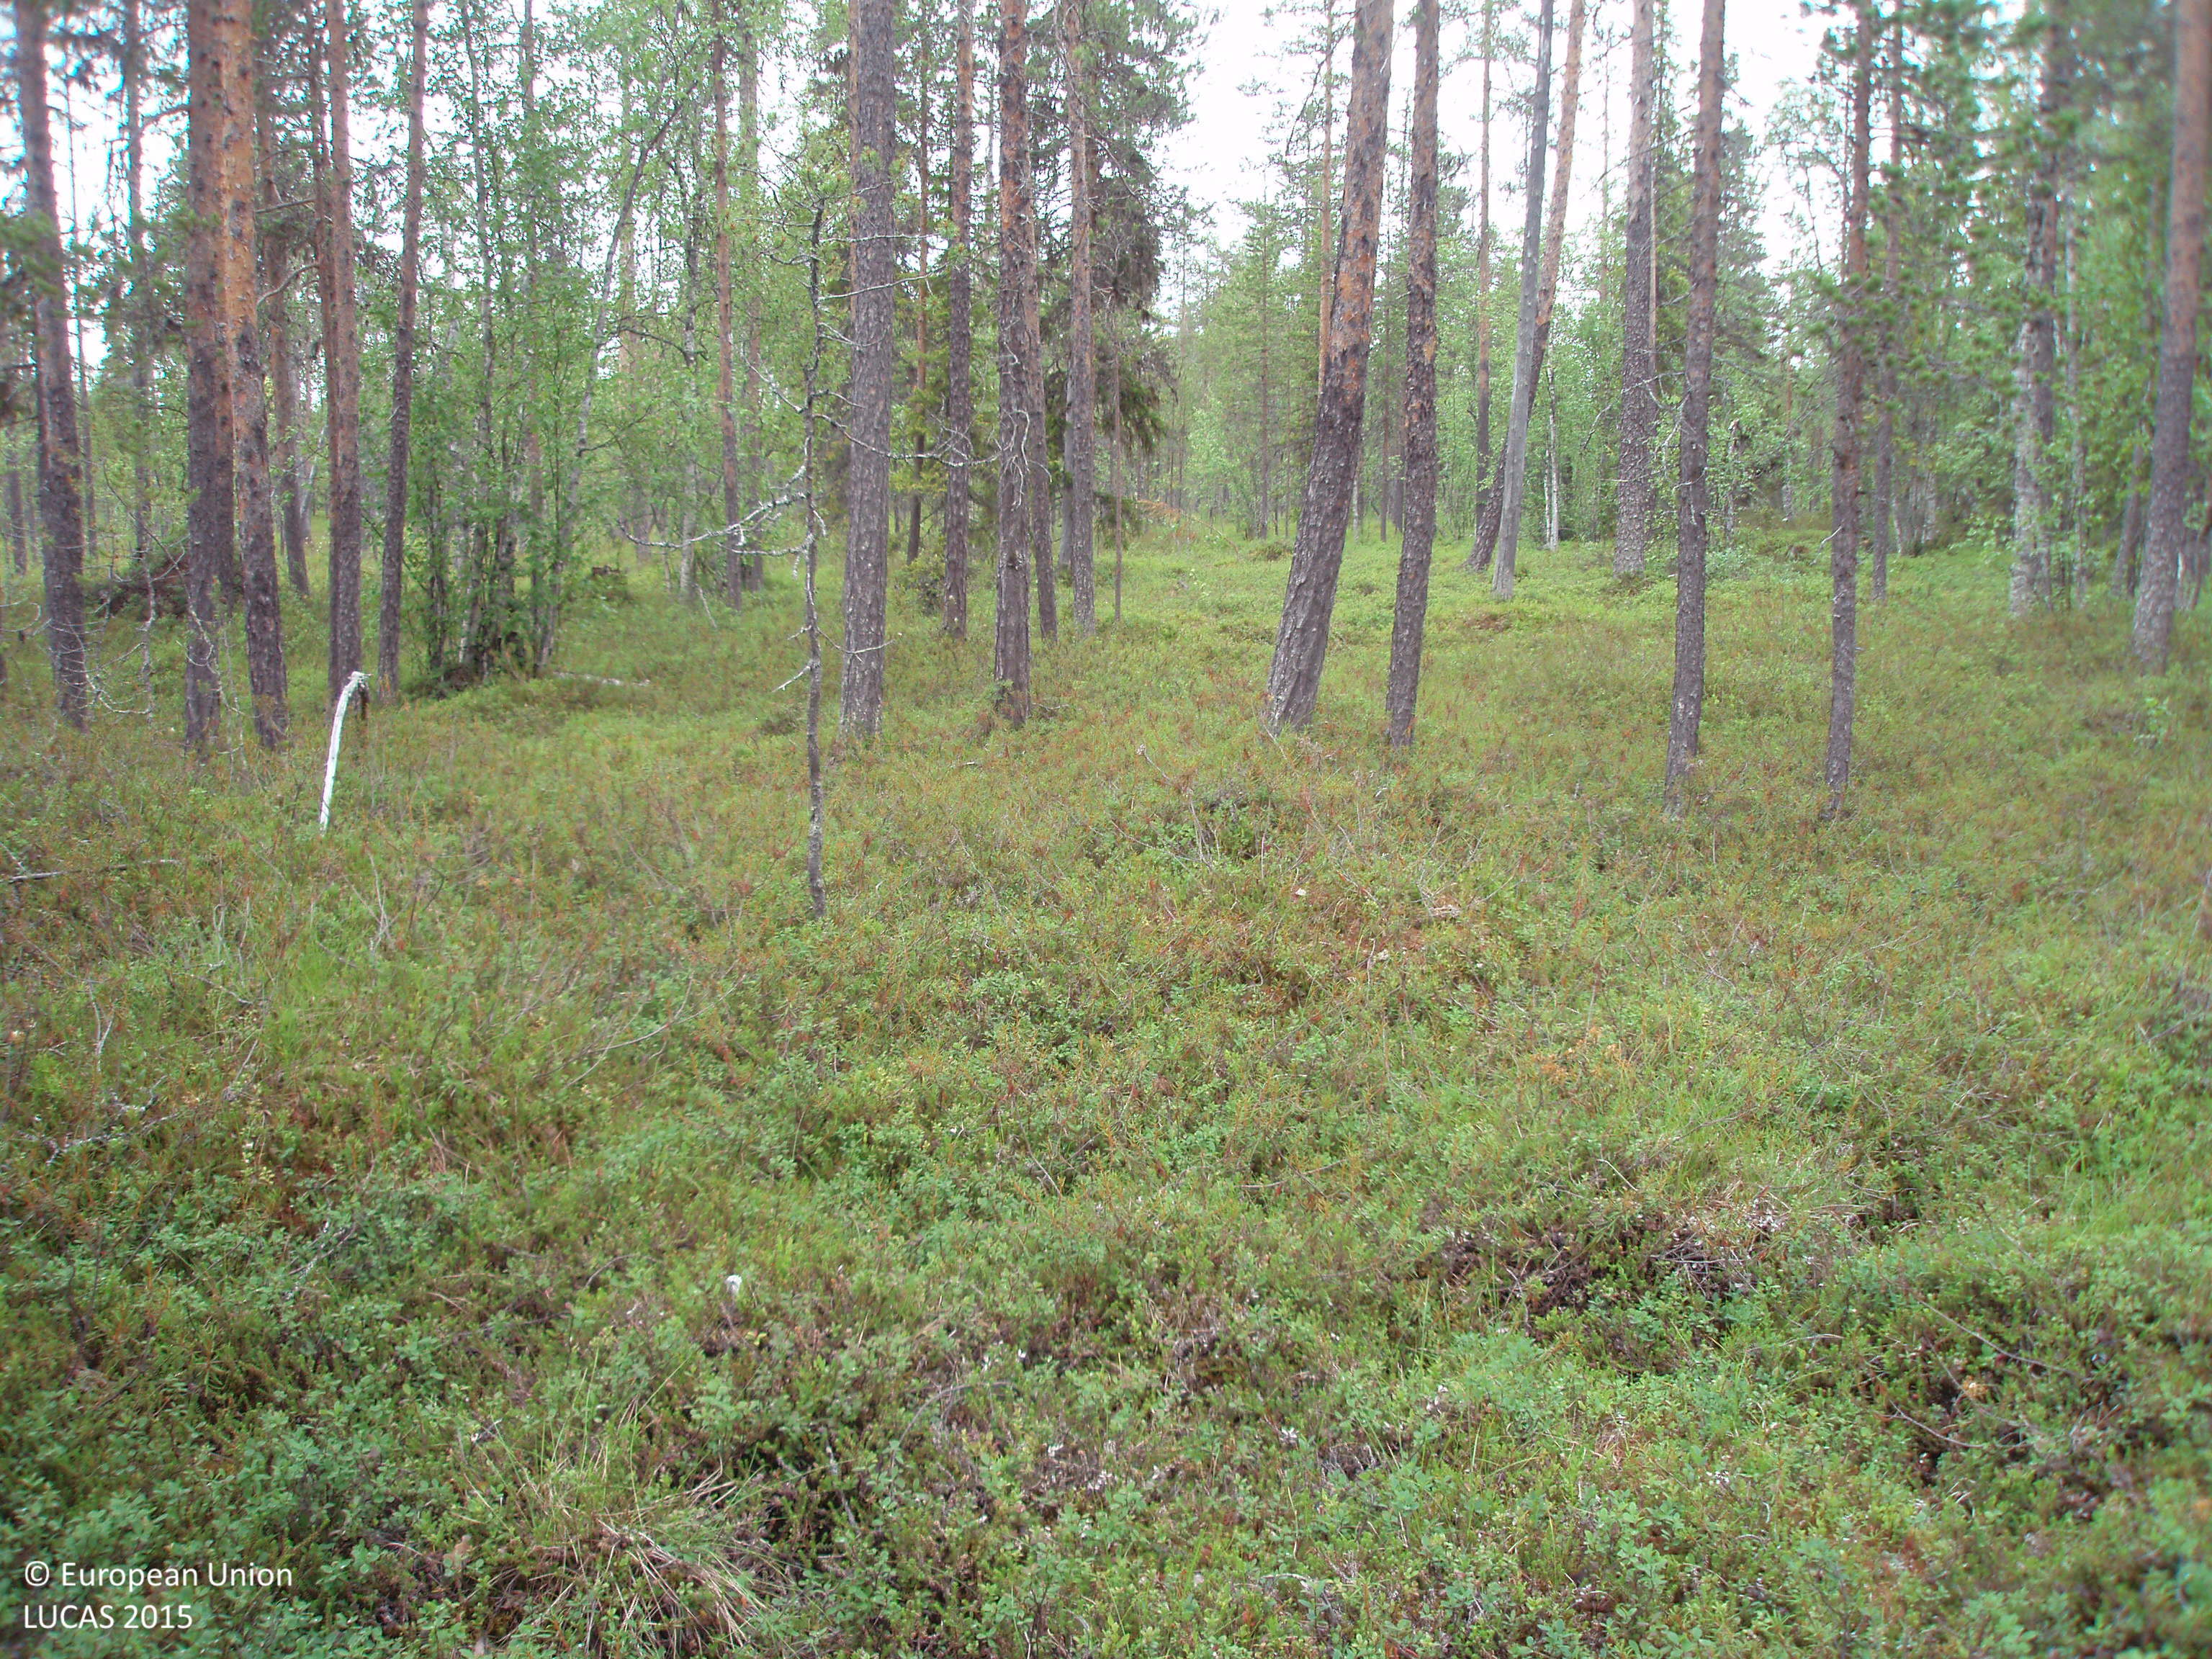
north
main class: Woodland
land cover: Pine dominated mixed woodland
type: boreal forest
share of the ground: 50 - 75 %
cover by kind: shrubs 40 %, coniferous forest trees 35 %, broadleaved forest trees 15 %, herbaceous plants 5 %, lichens and mosses 5 %
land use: Forestry
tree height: > 5 m
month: July
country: FI
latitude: 67.1871
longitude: 27.7926
